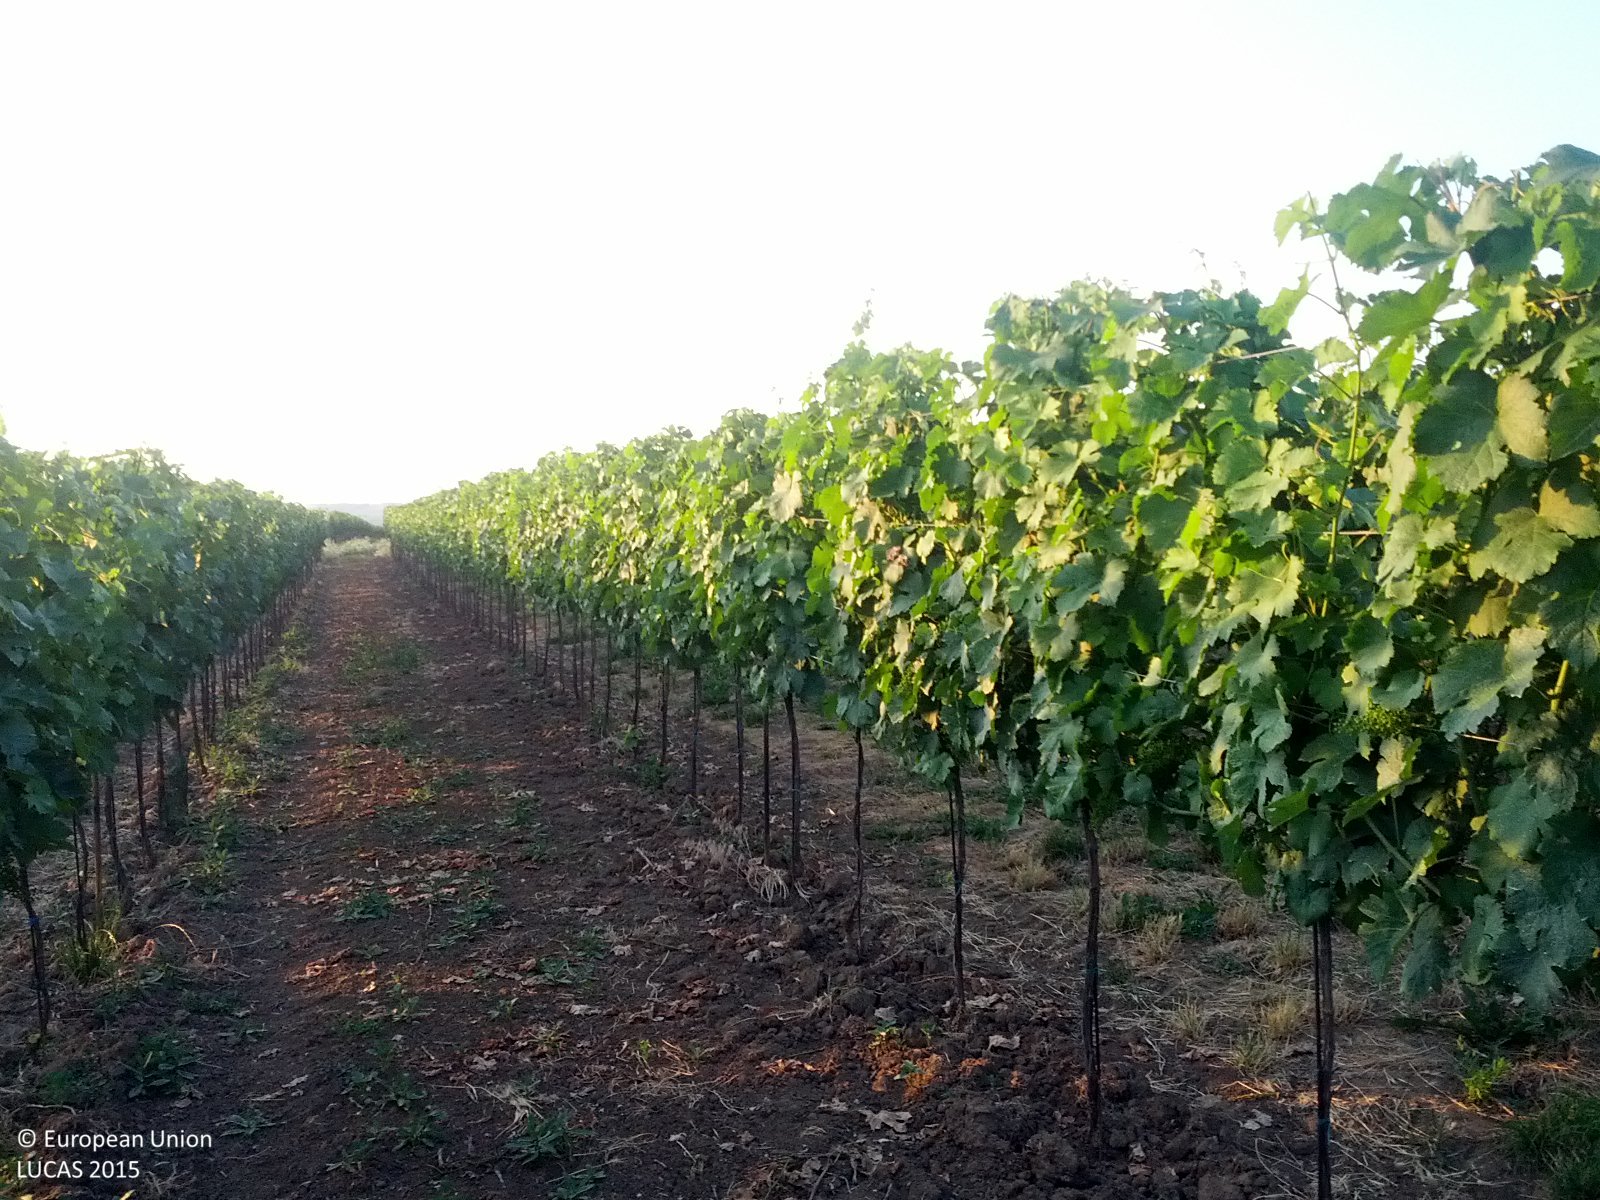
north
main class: Cropland
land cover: Vineyards
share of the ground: 25 - 50 %
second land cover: Spontaneously vegetated surfaces
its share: < 10 %
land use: Agriculture (excluding fallow land and kitchen gardens)
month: July
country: AT
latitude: 48.6369
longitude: 16.6427
